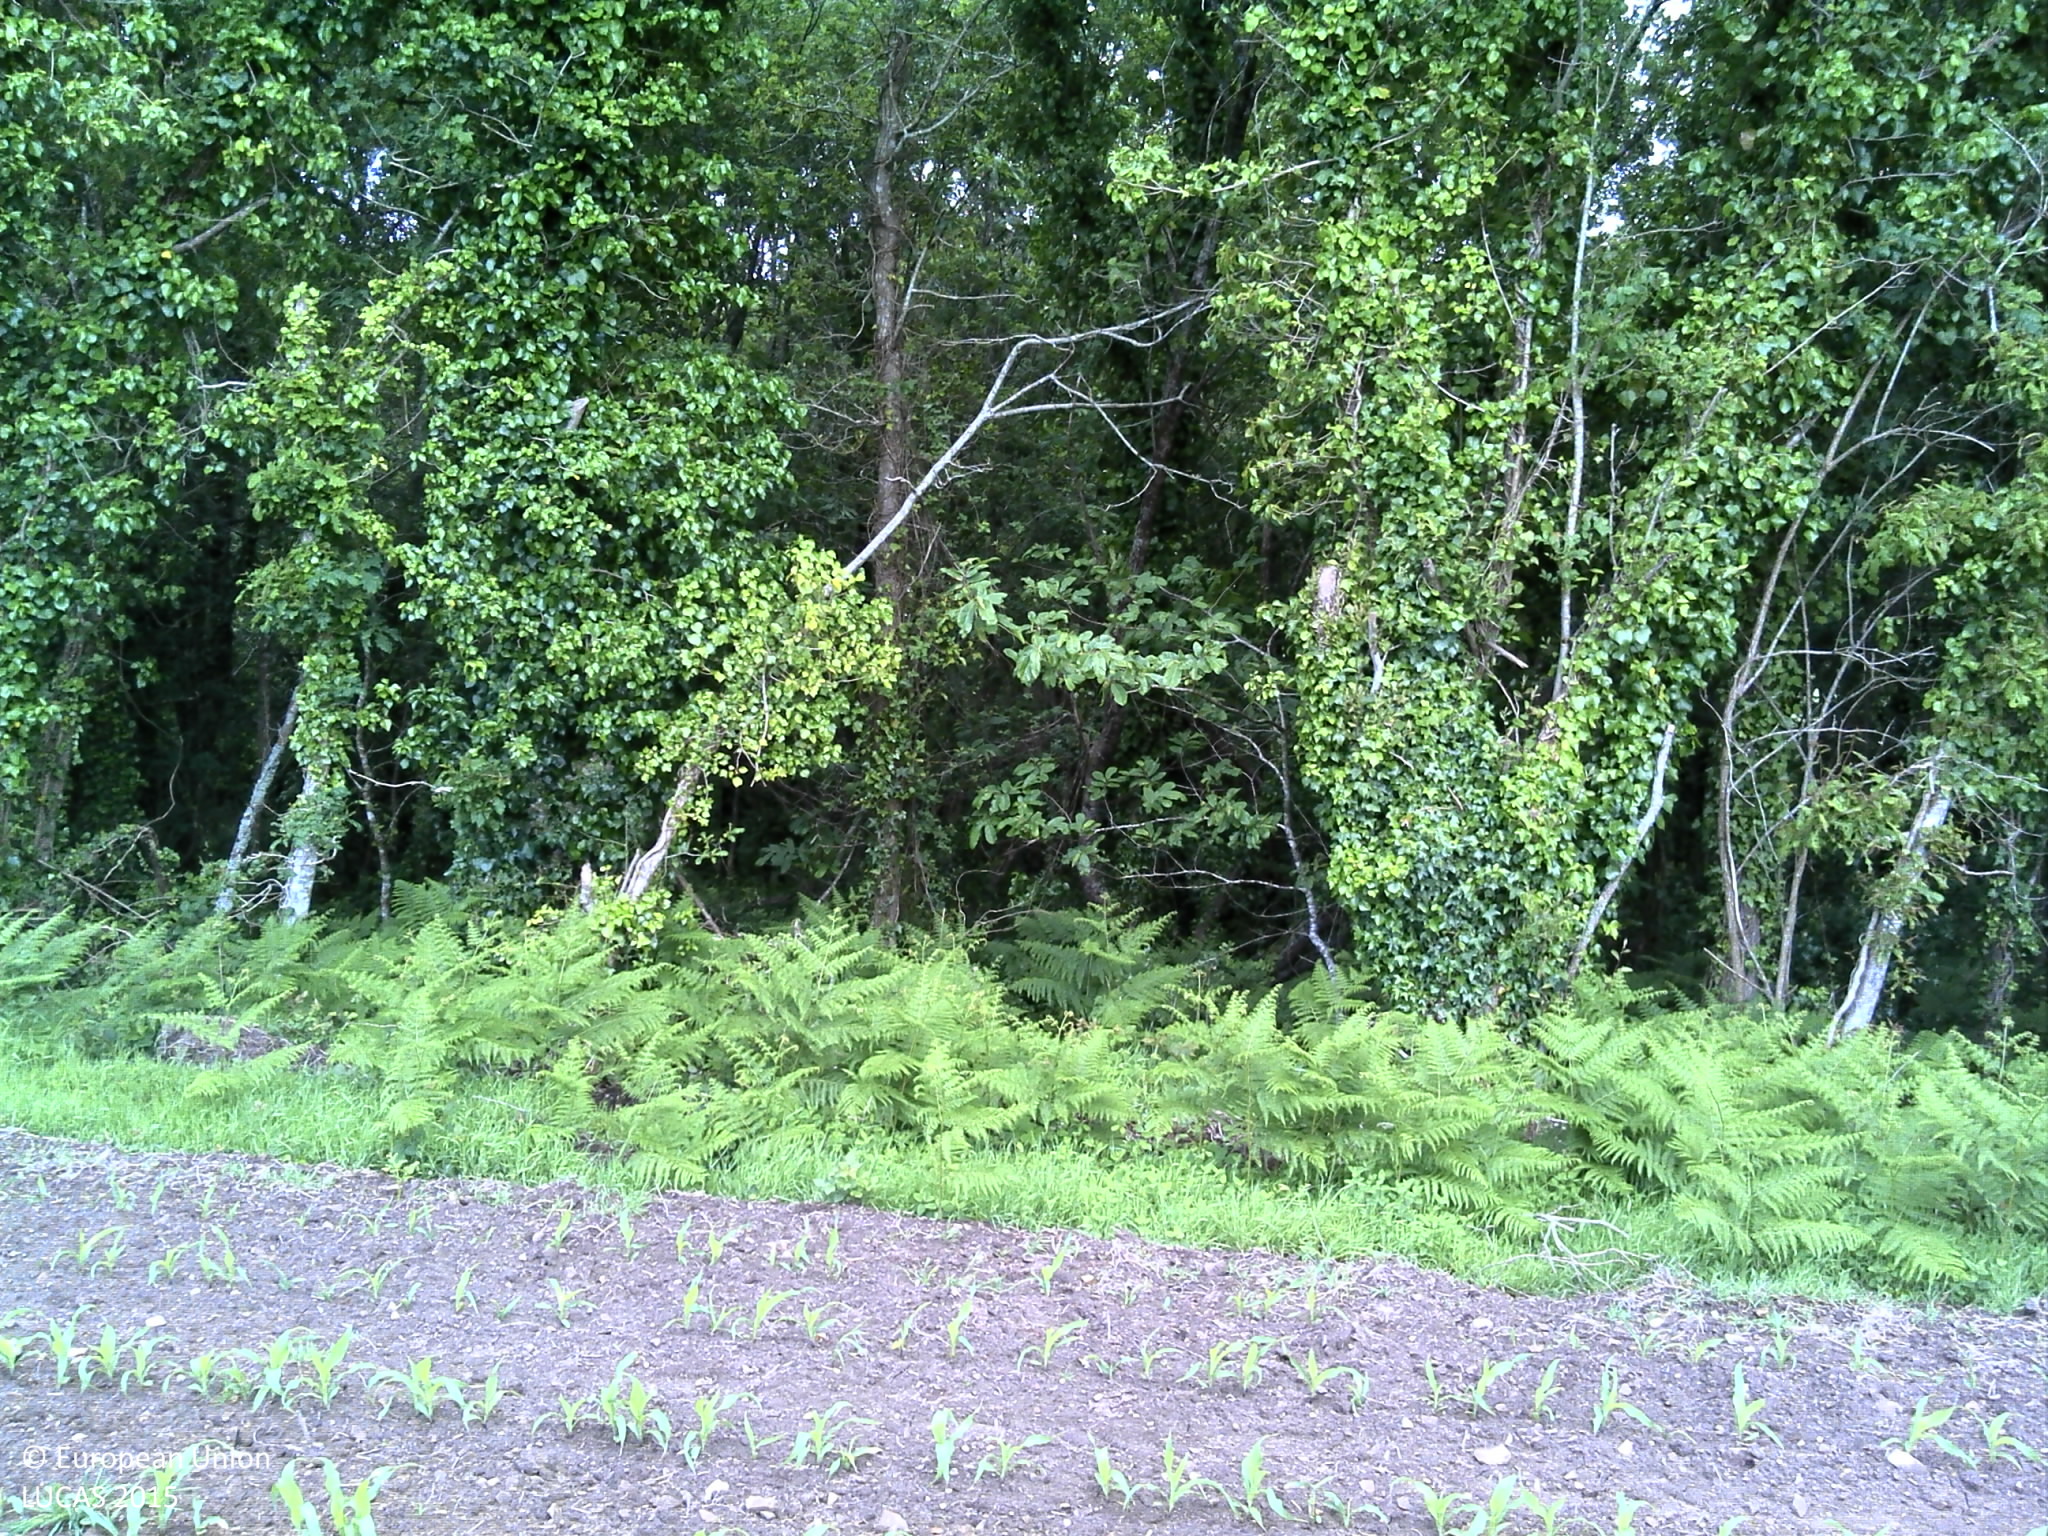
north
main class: Cropland
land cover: Maize
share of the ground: 10 - 25 %
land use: Agriculture (excluding fallow land and kitchen gardens)
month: September
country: FR
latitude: 47.8020
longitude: -3.5483
